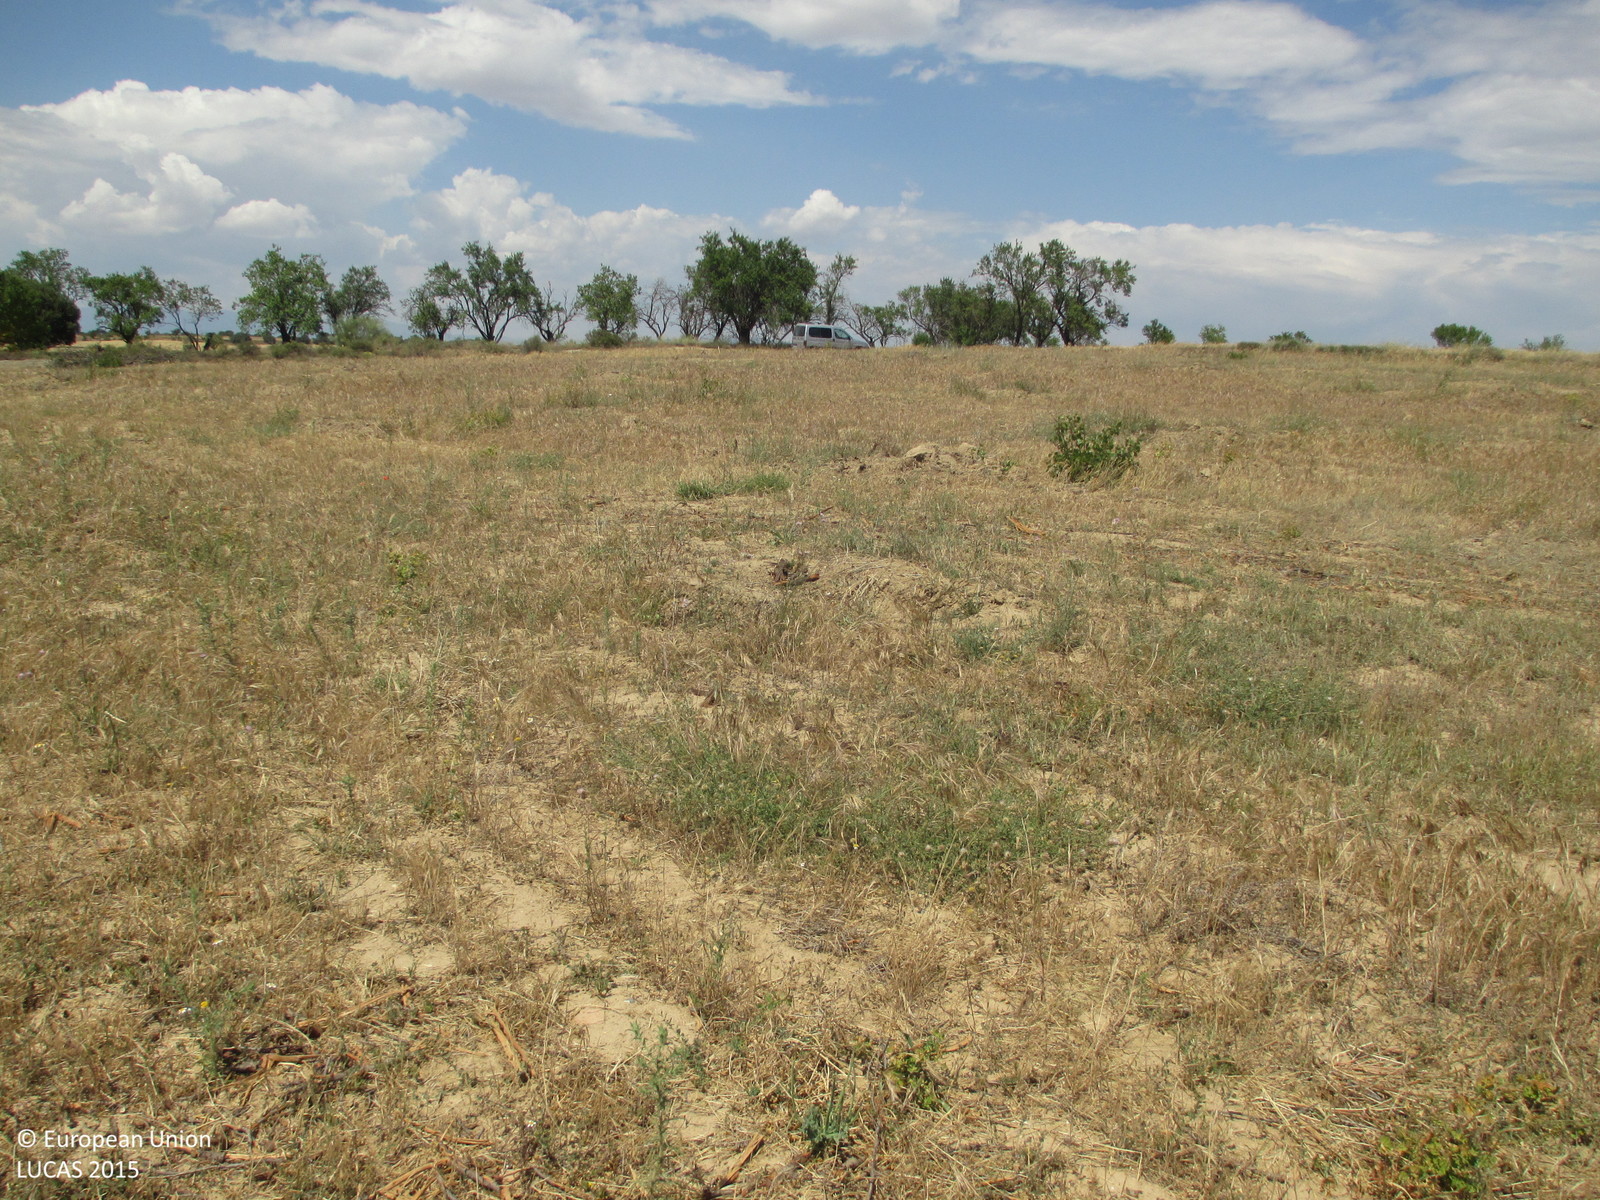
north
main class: Grassland
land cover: Spontaneously vegetated surfaces
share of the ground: 50 - 75 %
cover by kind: herbaceous plants 65 %, unconsolidated bare surface 35 %
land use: Fallow land
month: May
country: ES
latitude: 41.9559
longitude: -0.0199
